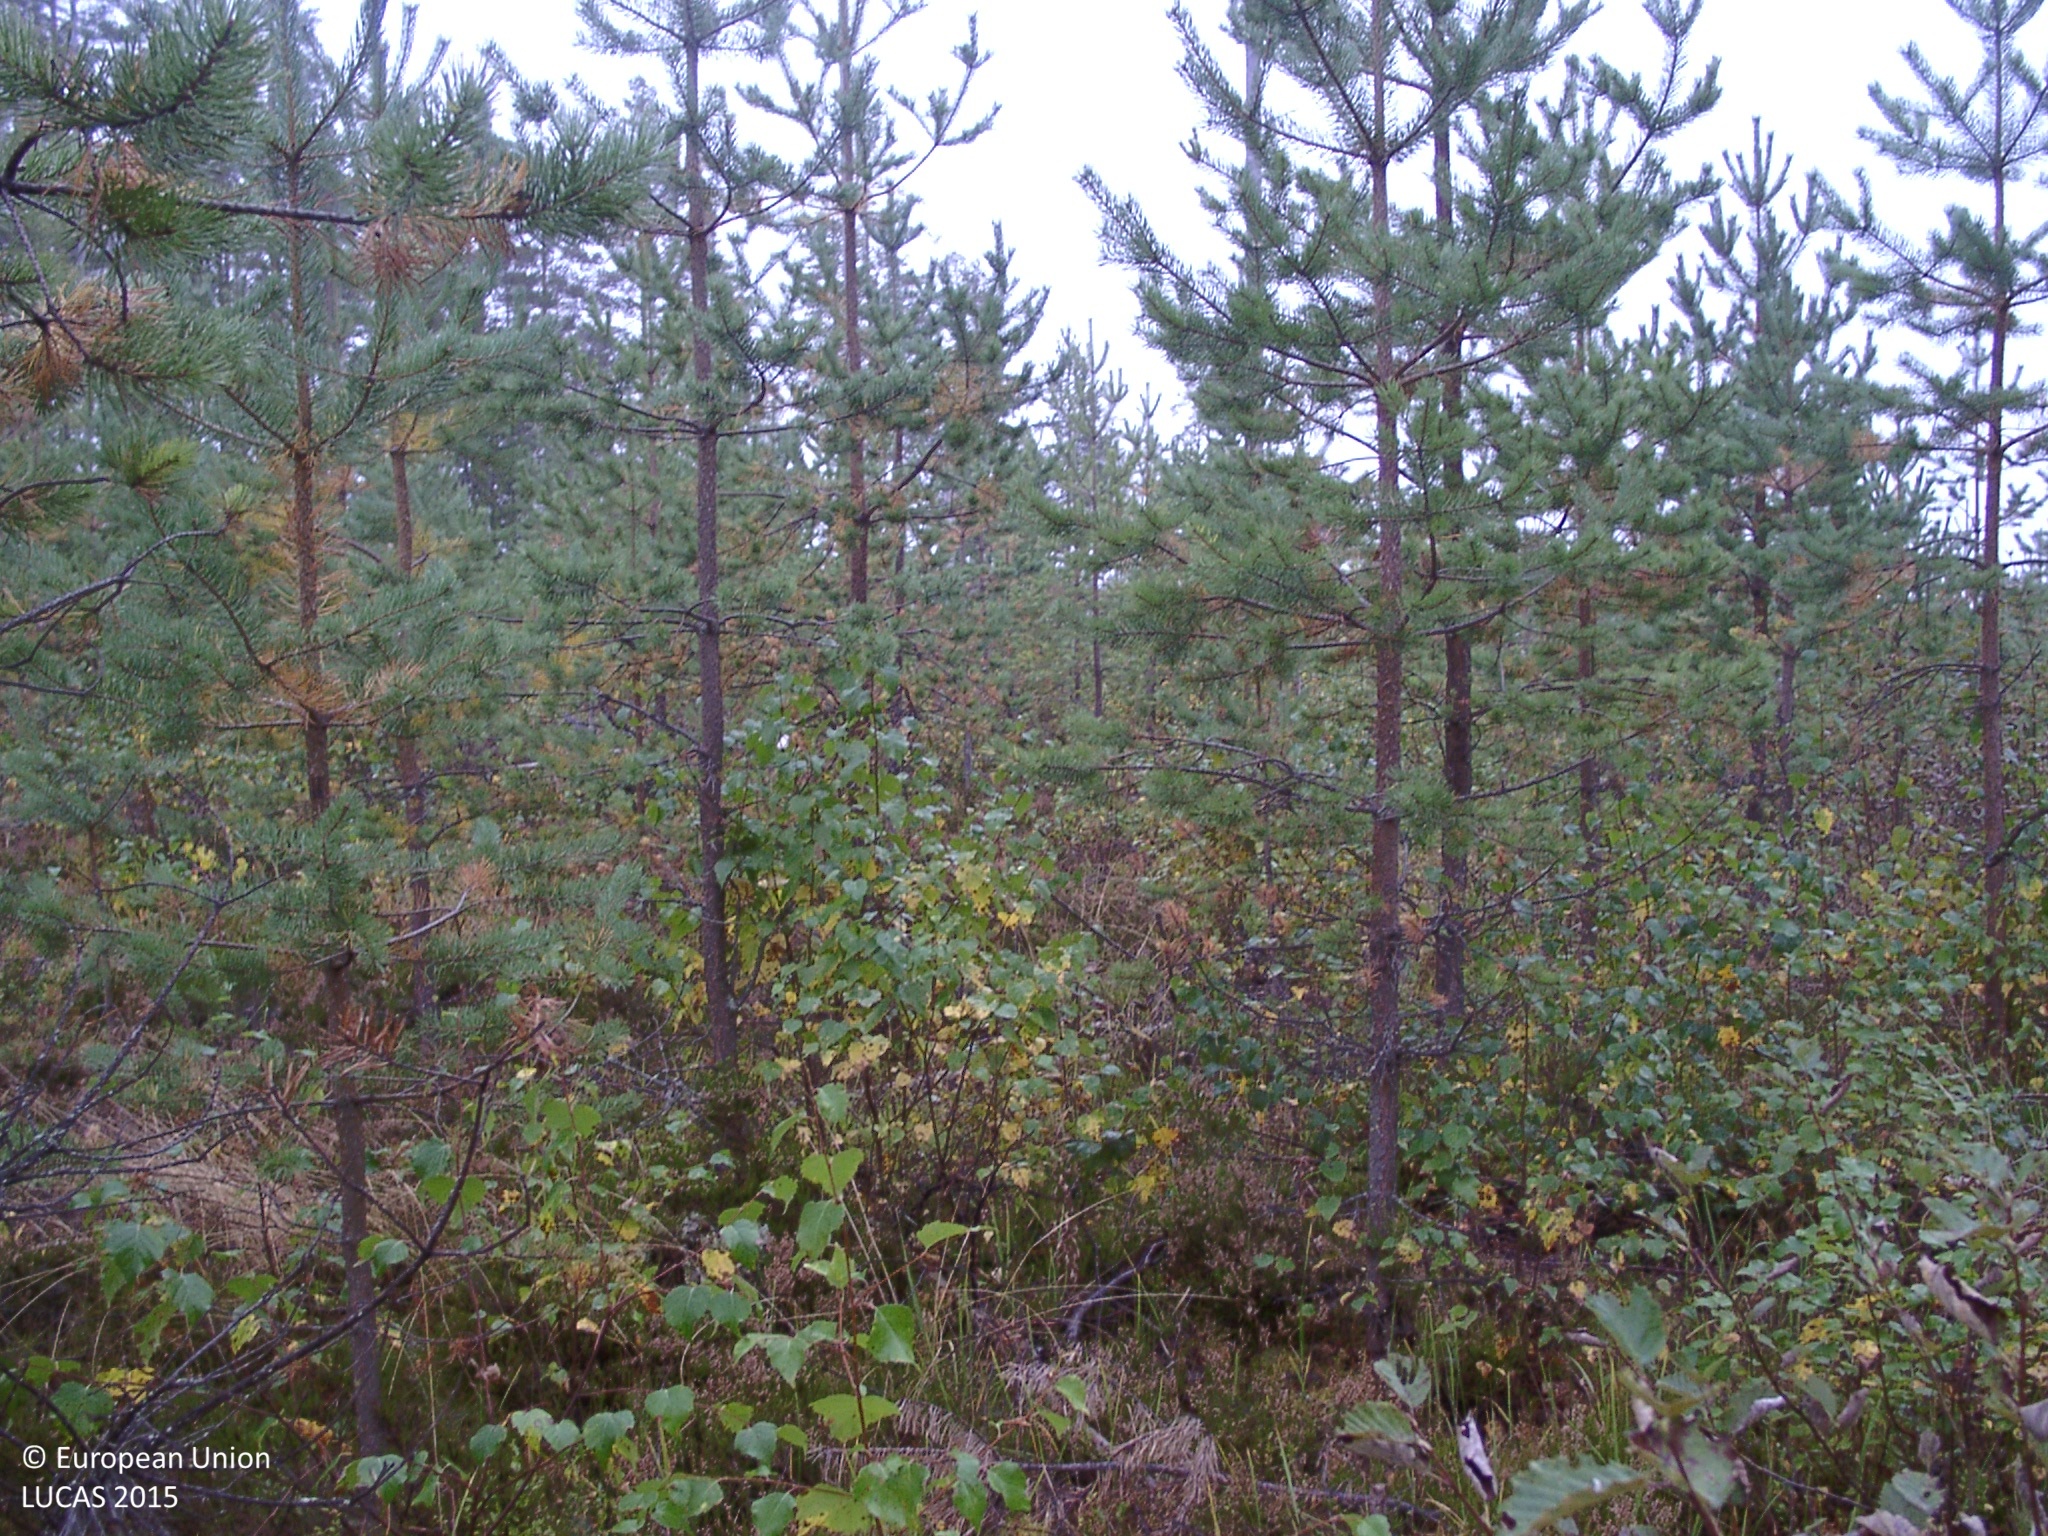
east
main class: Woodland
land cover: Pine dominated mixed woodland
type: boreal forest
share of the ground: 25 - 50 %
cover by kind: shrubs 35 %, coniferous forest trees 30 %, broadleaved forest trees 15 %, lichens and mosses 15 %, herbaceous plants 5 %
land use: Forestry
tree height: < 5 m
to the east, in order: Pine dominated mixed woodland; Pine dominated coniferous woodland; Pine dominated mixed woodland; Pine dominated coniferous woodland; Other mixed woodland; Ditches and canals; Tracks; Broadleaved woodland
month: September
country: FI
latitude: 62.7086
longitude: 25.6550
